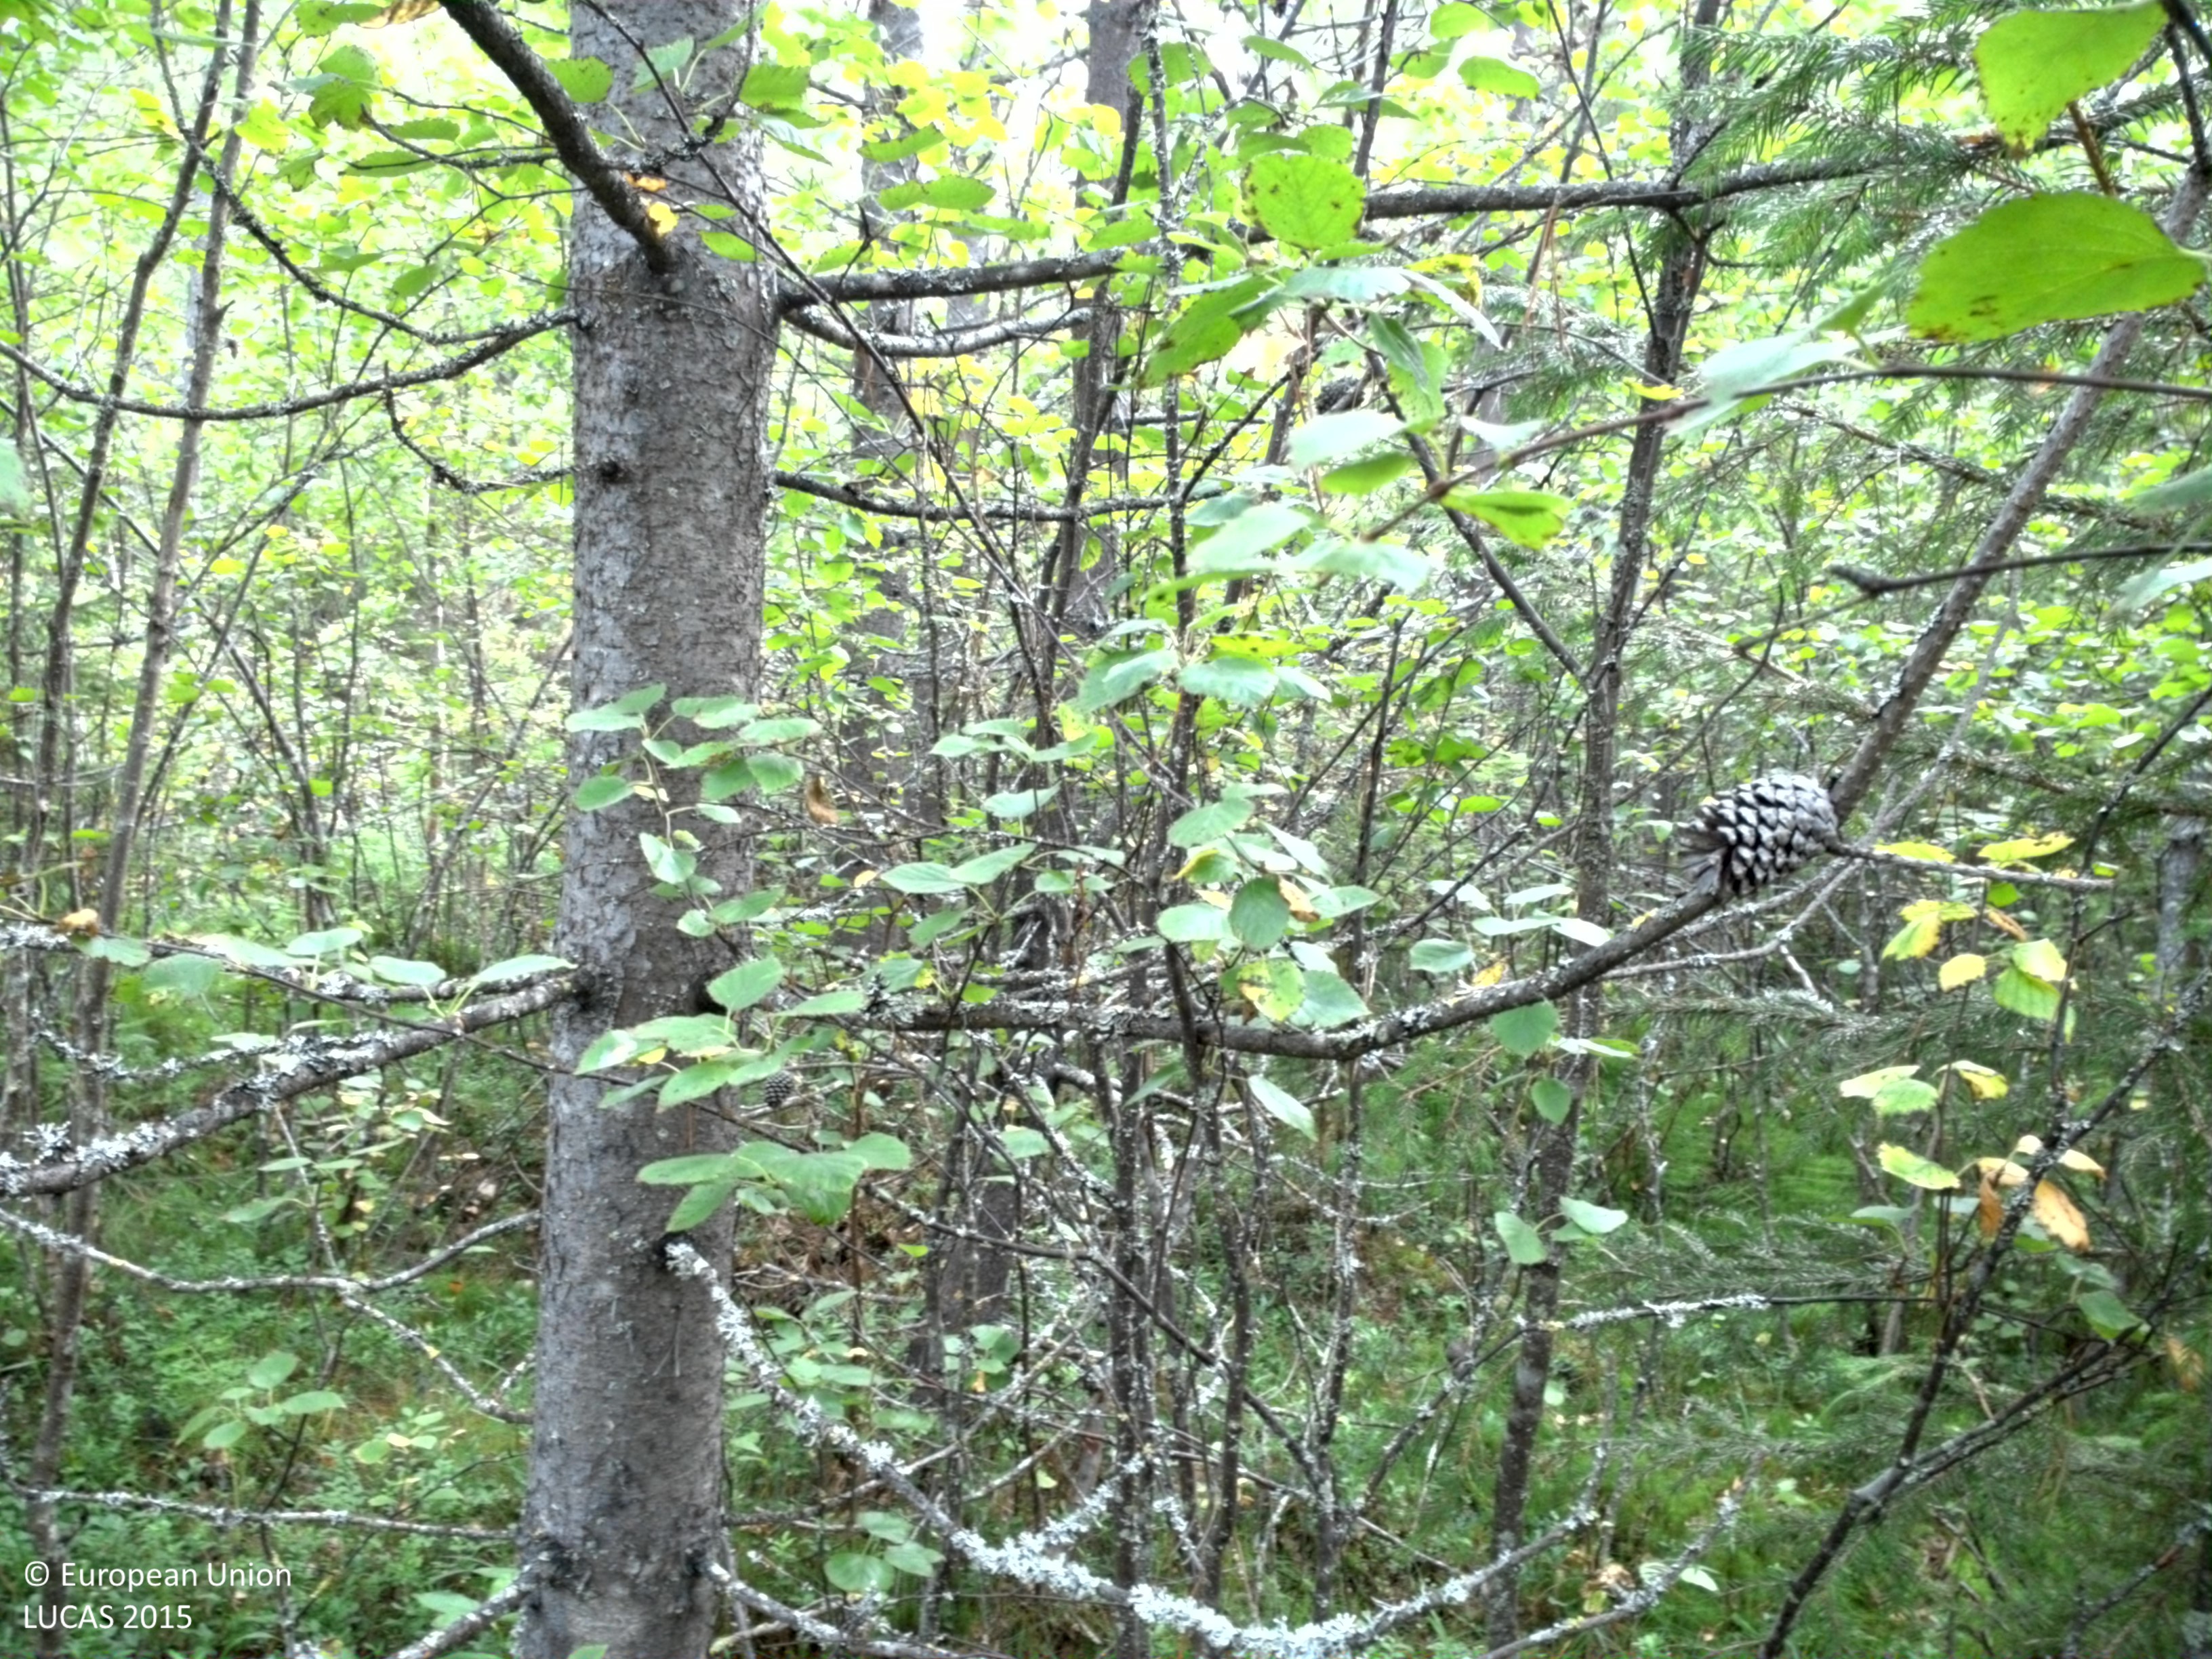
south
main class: Woodland
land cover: Pine dominated mixed woodland
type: exotic forest
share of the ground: > 75 %
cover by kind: broadleaved forest trees 45 %, coniferous forest trees 35 %, shrubs 20 %
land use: Forestry
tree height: > 5 m
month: August
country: SE
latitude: 66.0427
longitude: 22.5806
